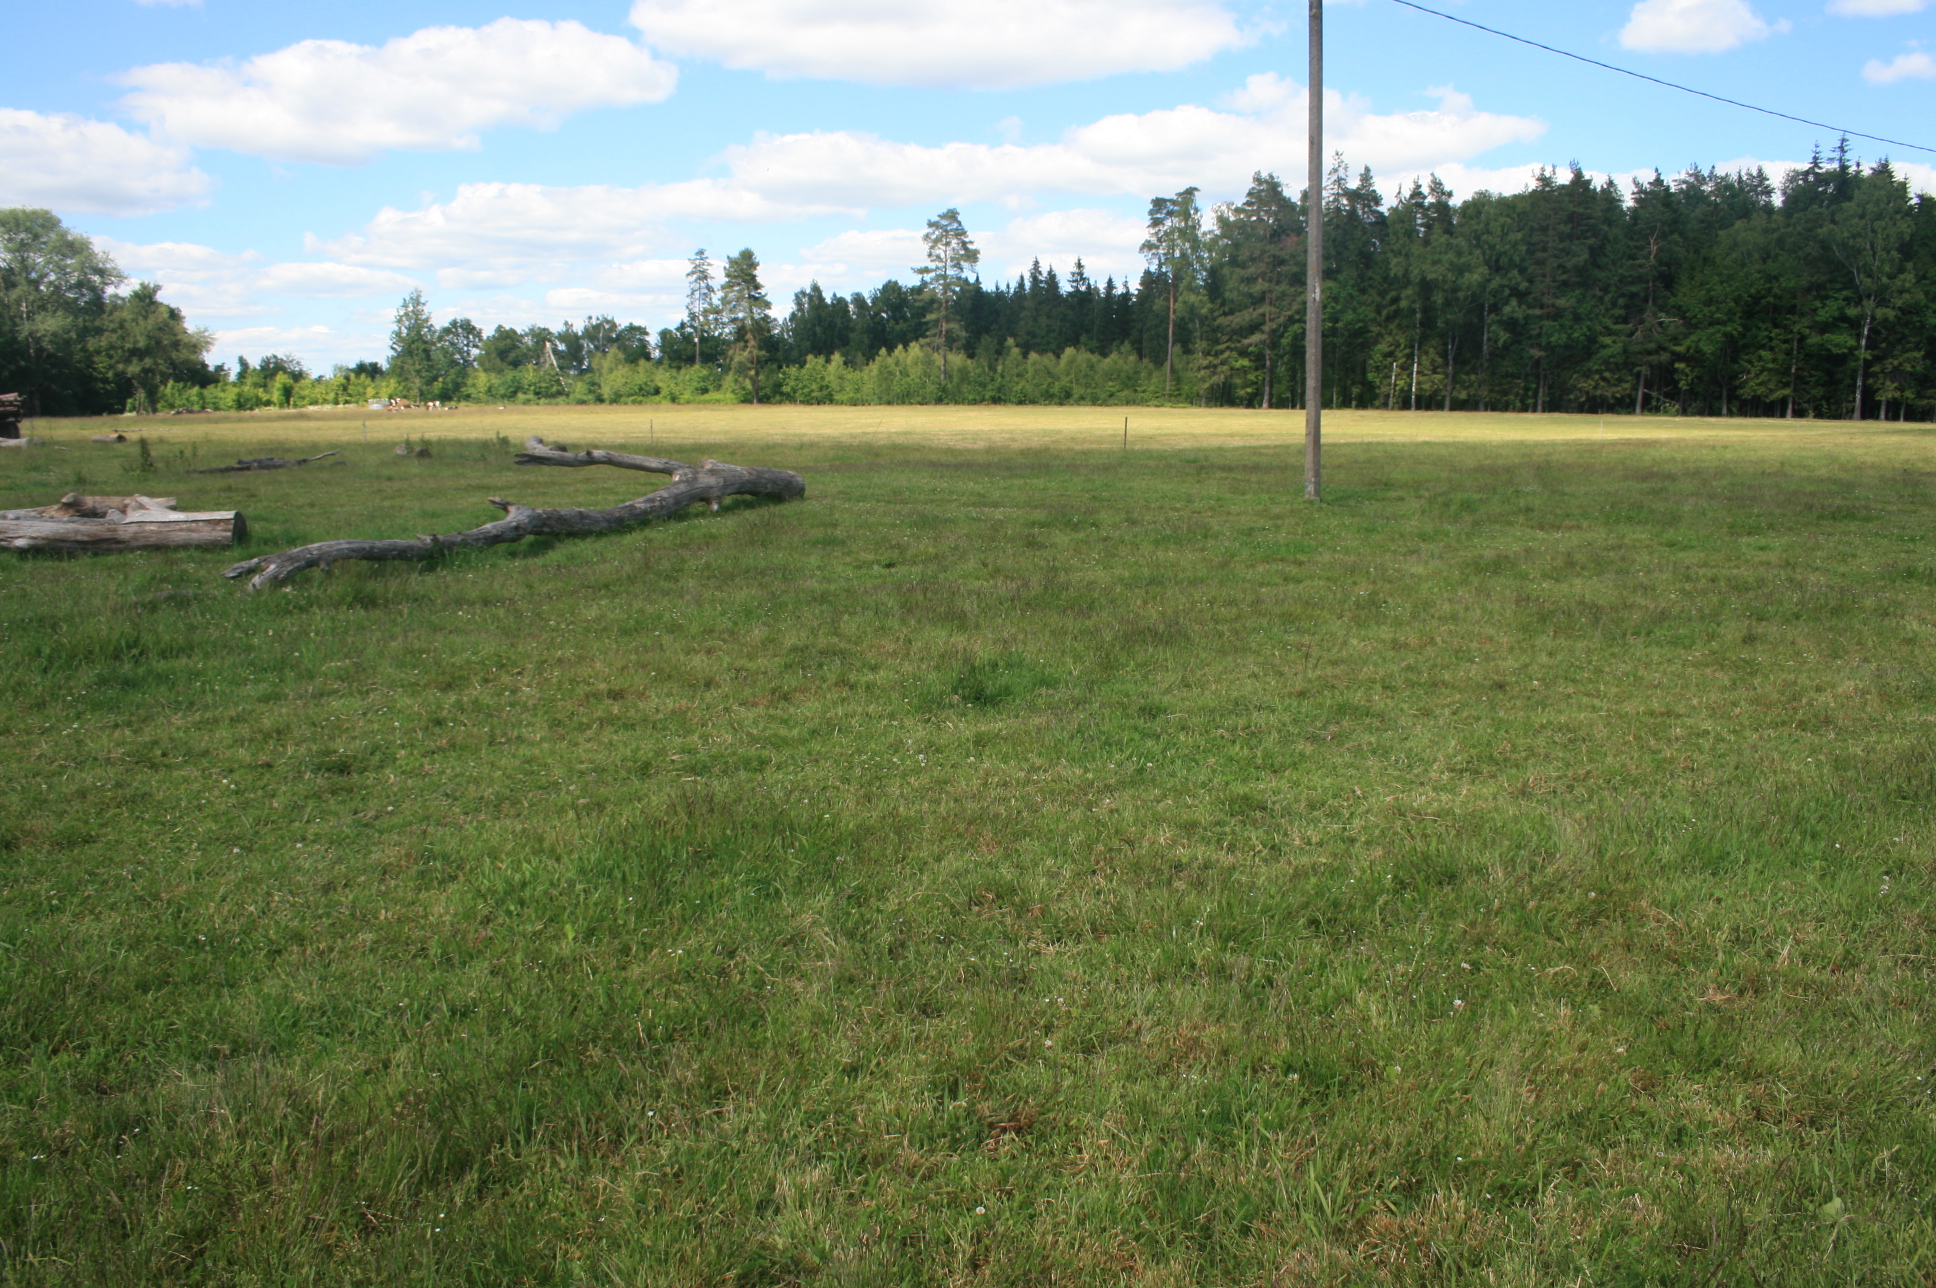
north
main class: Grassland
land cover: Grassland without tree/shrub cover
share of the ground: > 75 %
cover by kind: herbaceous plants 100 %
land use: Agriculture (excluding fallow land and kitchen gardens)
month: June
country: LT
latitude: 55.4177
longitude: 22.0445
